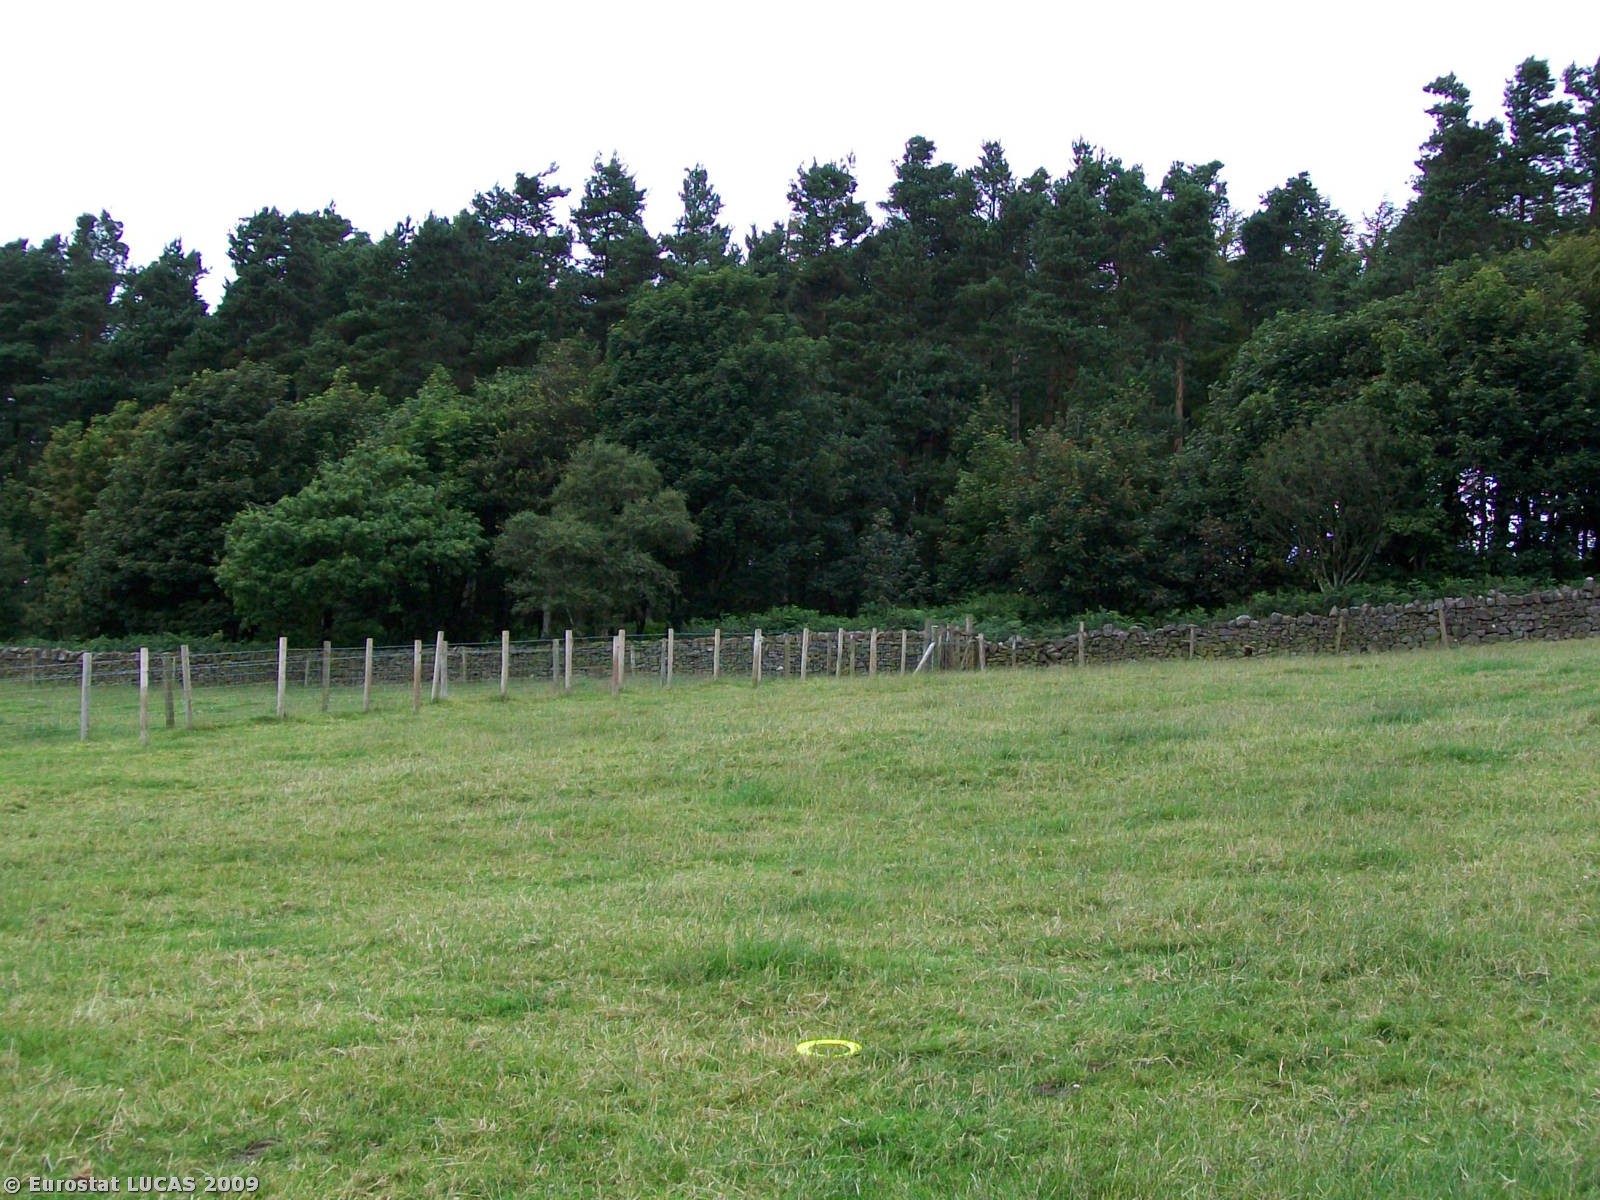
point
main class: Grassland
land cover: Grassland without tree/shrub cover
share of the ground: > 75 %
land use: Agriculture (excluding fallow land and kitchen gardens)
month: July
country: GB
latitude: 55.0353
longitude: -3.2981
